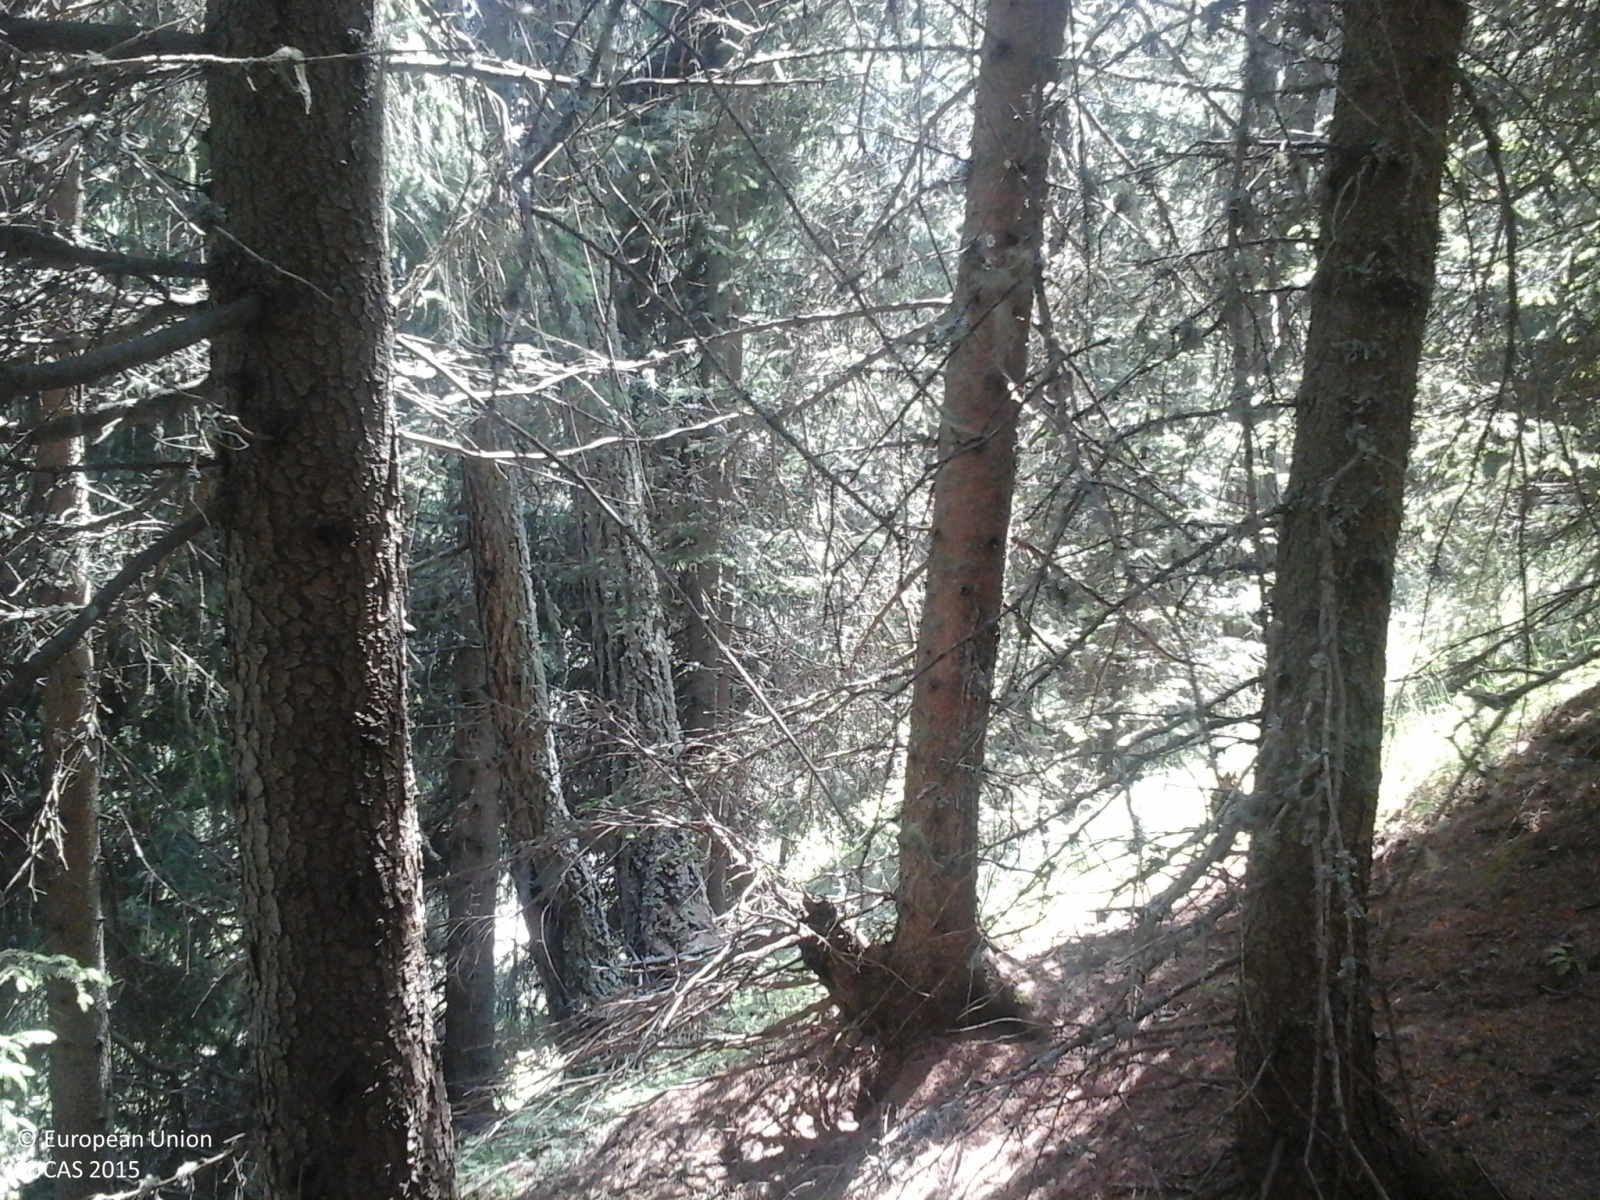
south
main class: Woodland
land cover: Other coniferous woodland
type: alpine coniferous forest
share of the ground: > 75 %
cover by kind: coniferous forest trees 100 %
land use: Forestry
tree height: > 5 m
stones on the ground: < 10 %
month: July
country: IT
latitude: 45.8033
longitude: 7.6743
